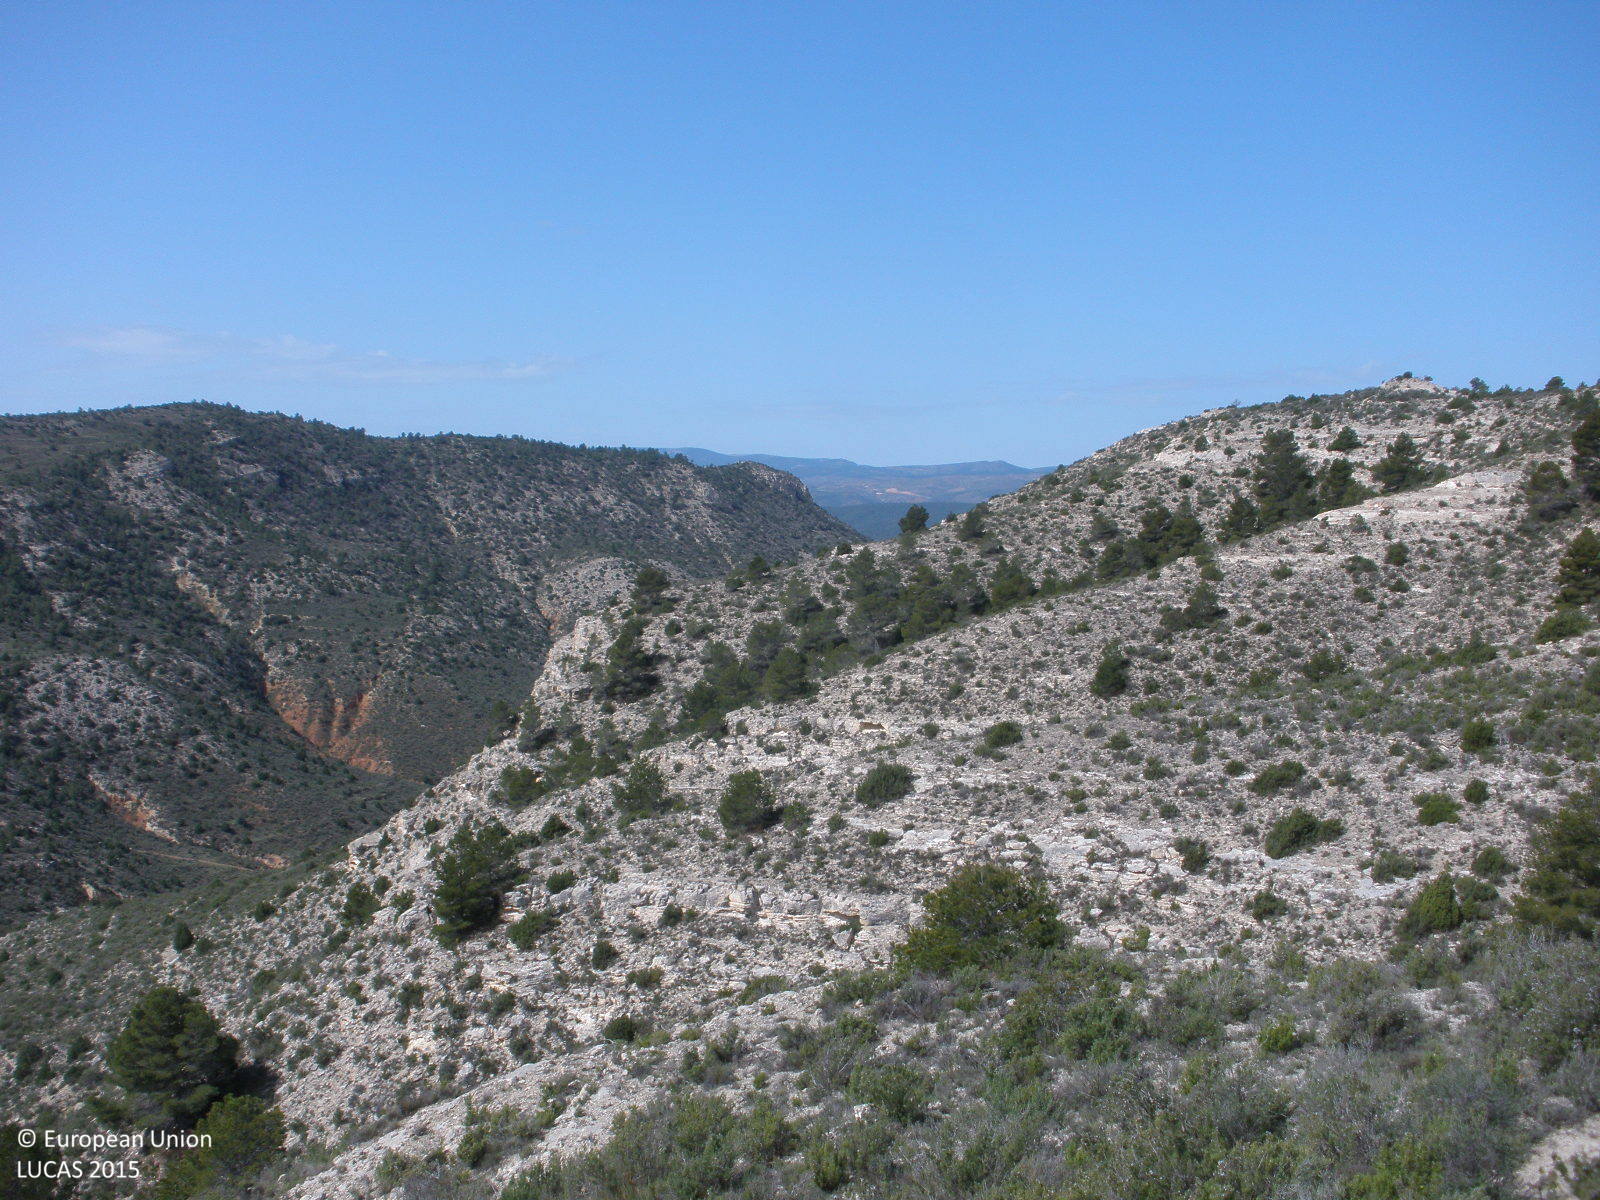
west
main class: Shrubland
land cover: Shrubland without tree cover
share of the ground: > 75 %
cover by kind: shrubs 80 %, consolidated bare surface 20 %
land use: Semi-natural and natural areas not in use
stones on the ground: 25 - 50 %
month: April
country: ES
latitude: 40.1534
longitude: -1.1971
